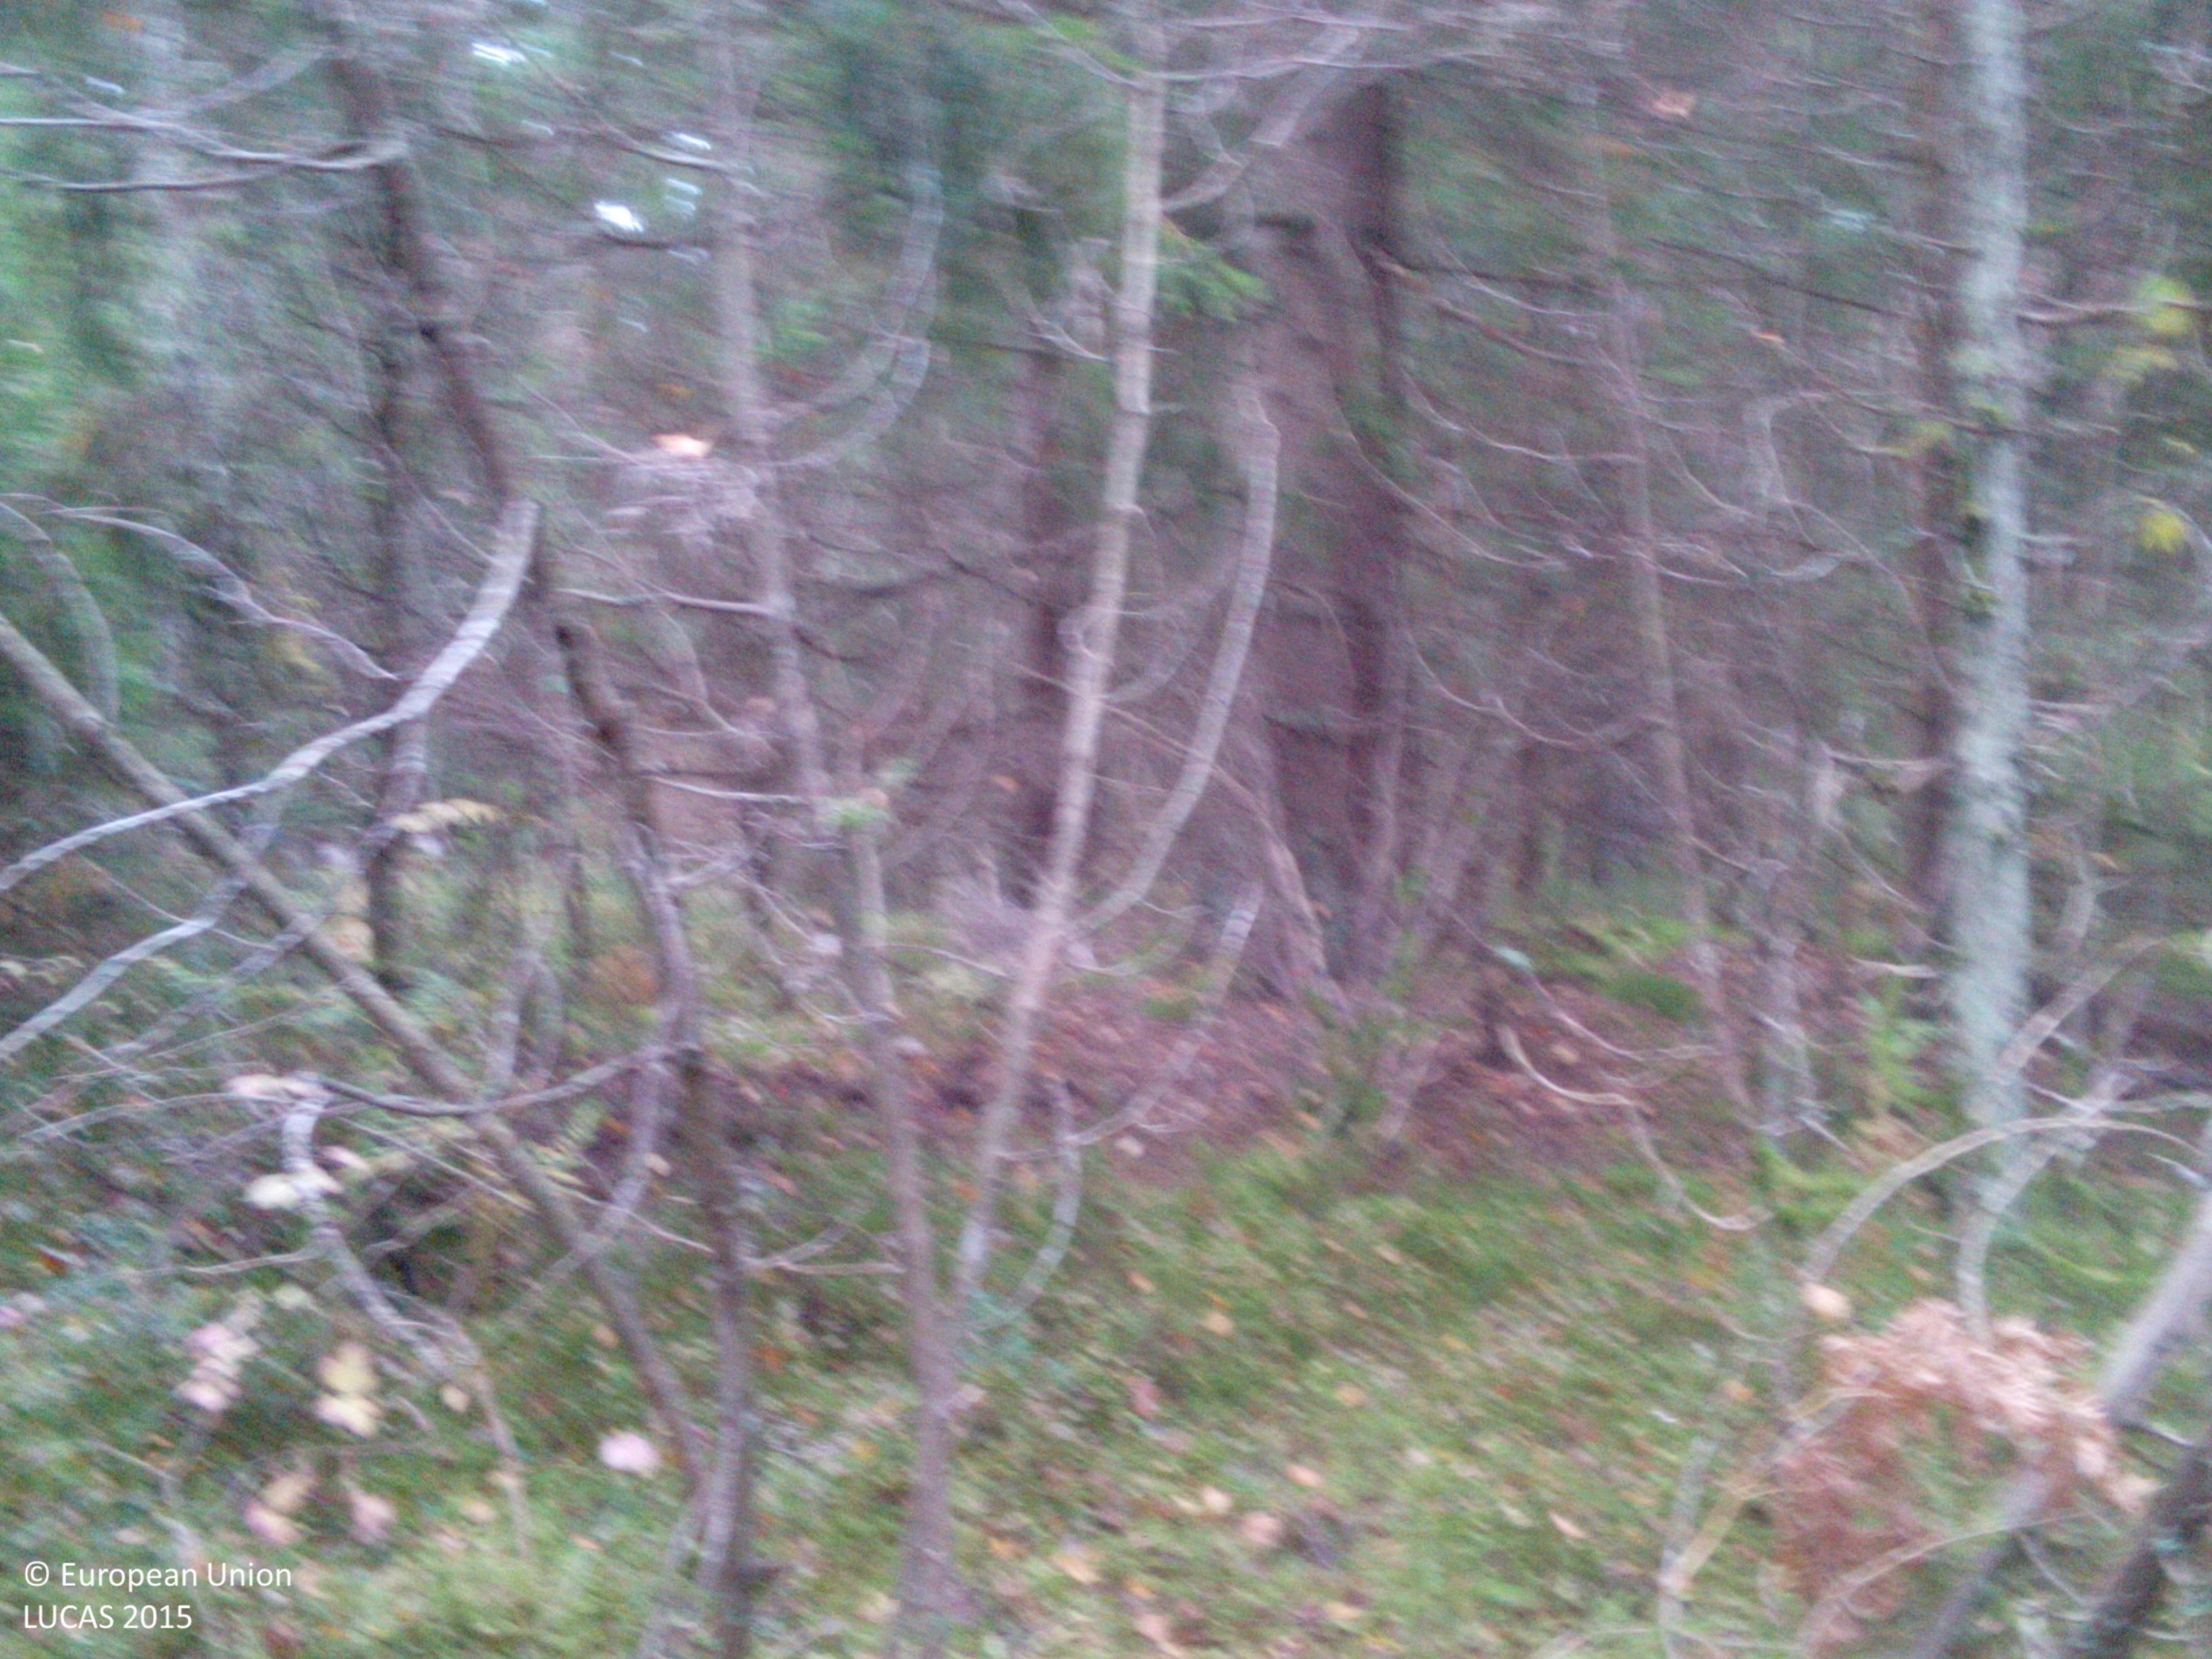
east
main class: Woodland
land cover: Spruce dominated coniferous woodland
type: boreal forest
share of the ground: > 75 %
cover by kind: coniferous forest trees 85 %, herbaceous plants 5 %, lichens and mosses 5 %, consolidated bare surface 5 %
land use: Forestry
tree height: > 5 m
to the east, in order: Spruce dominated coniferous woodland; Ditches and canals; Spruce dominated coniferous woodland
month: October
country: SE
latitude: 59.0488
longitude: 16.2518
